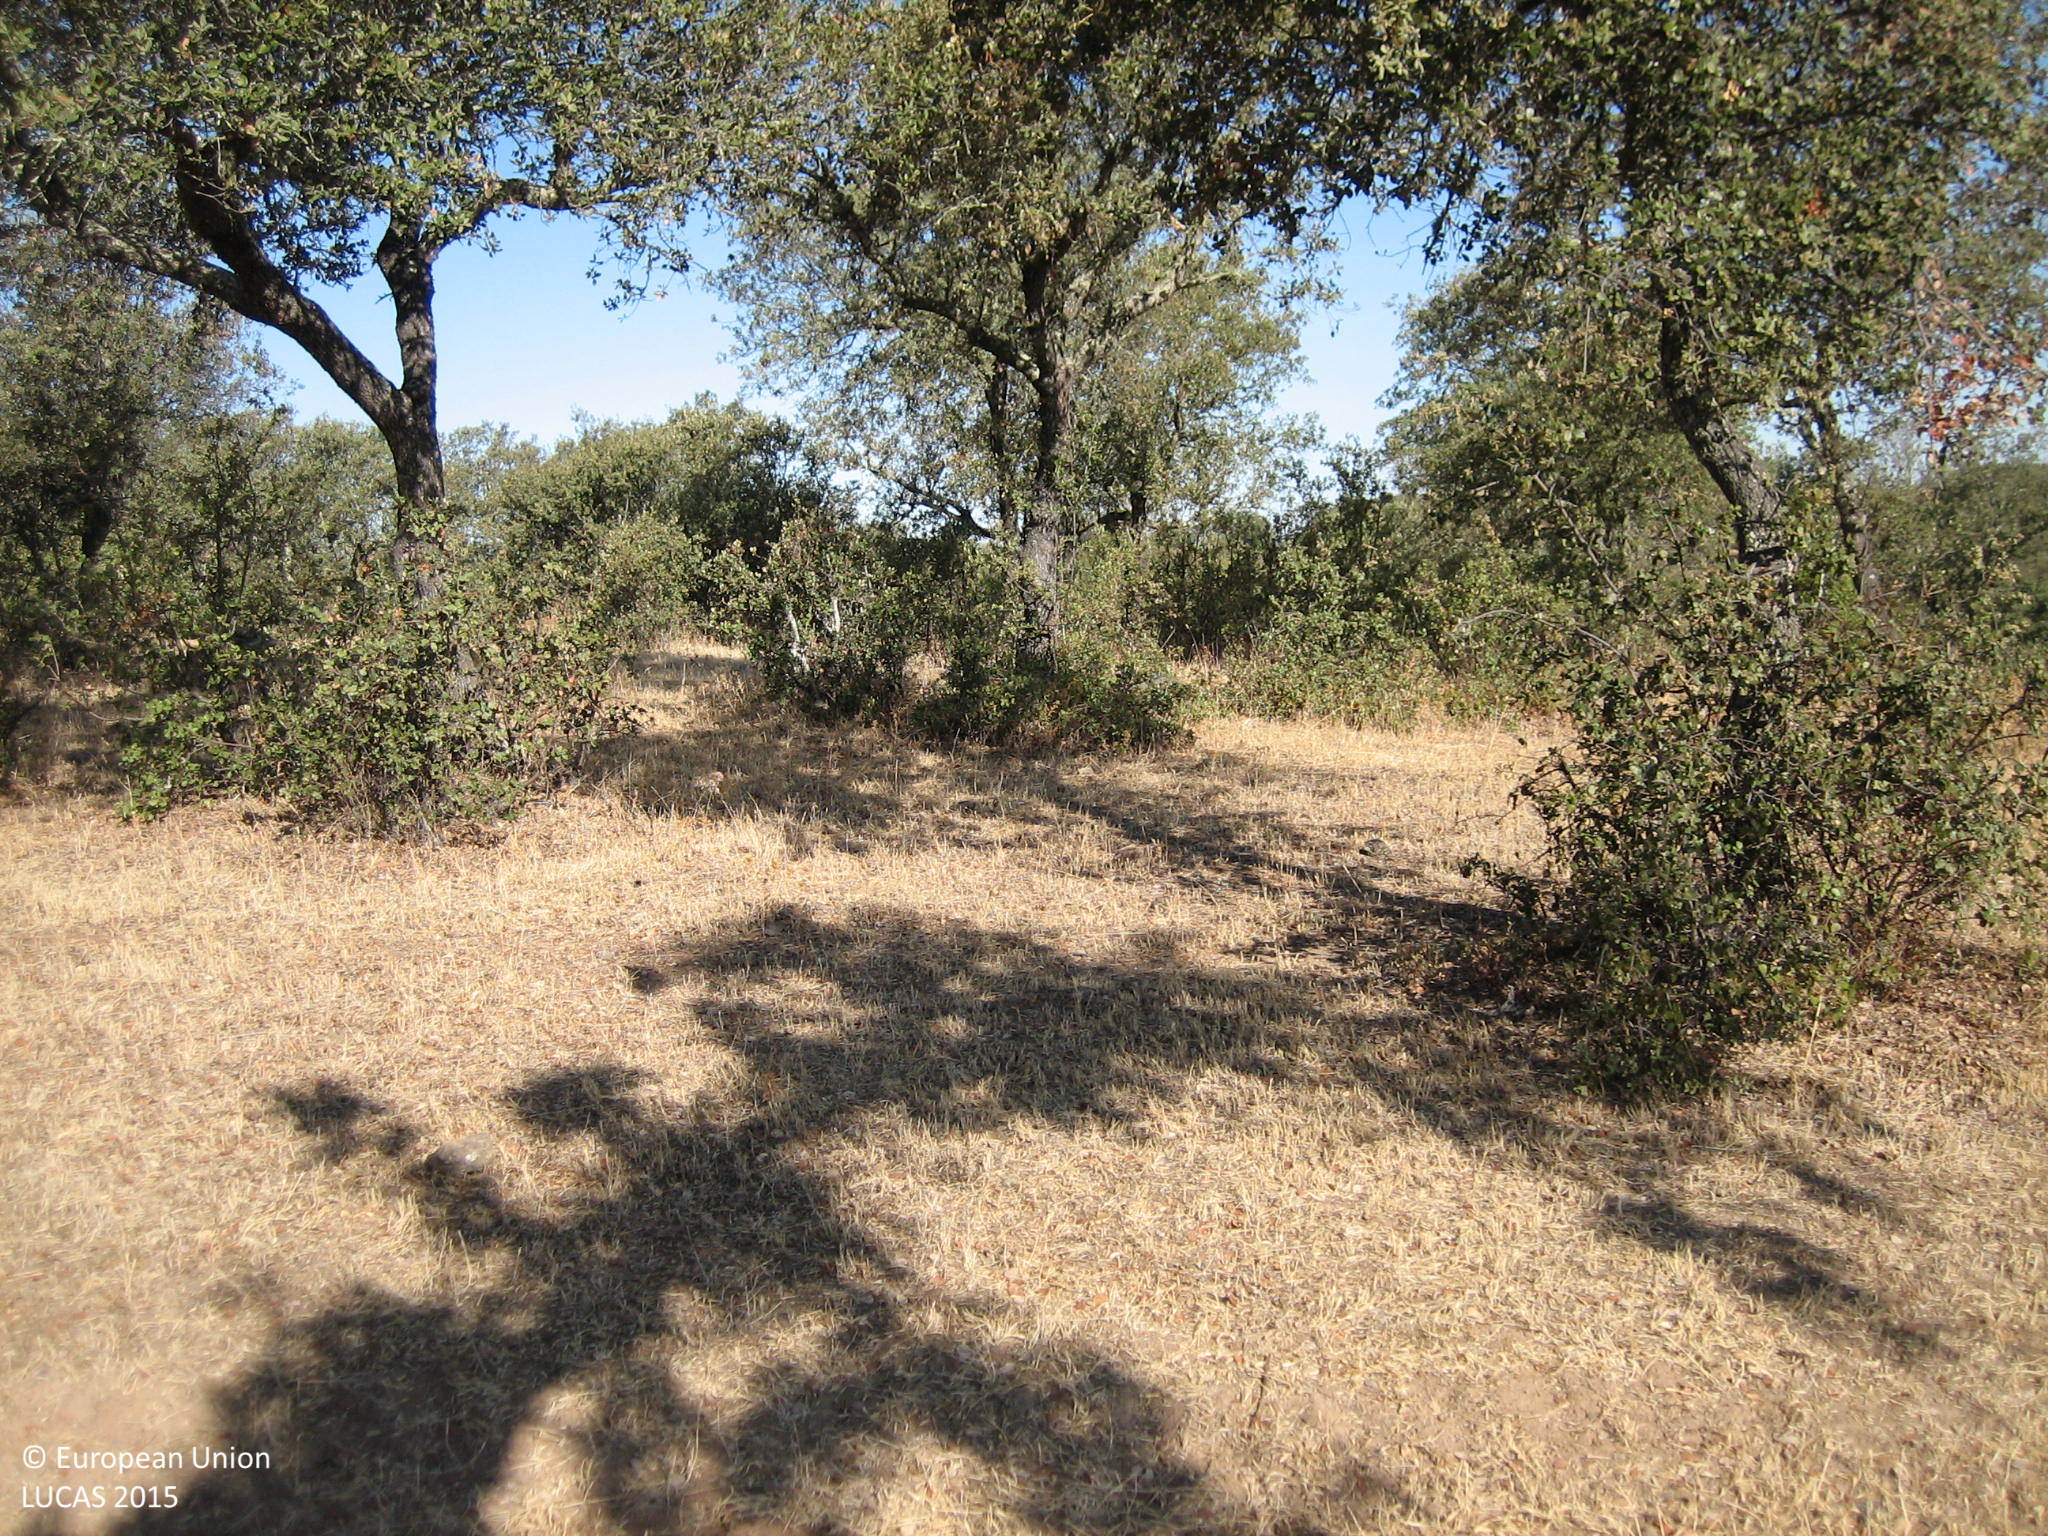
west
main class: Woodland
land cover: Broadleaved woodland
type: broadleaved evergreen forest
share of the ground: 10 - 25 %
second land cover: Grassland without tree/shrub cover
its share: > 75 %
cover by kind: herbaceous plants 80 %, broadleaved forest trees 10 %, unconsolidated bare surface 10 %
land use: Forestry
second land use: Agriculture (excluding fallow land and kitchen gardens)
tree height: < 5 m
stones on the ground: < 10 %
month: August
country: ES
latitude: 38.5427
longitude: -7.2449
